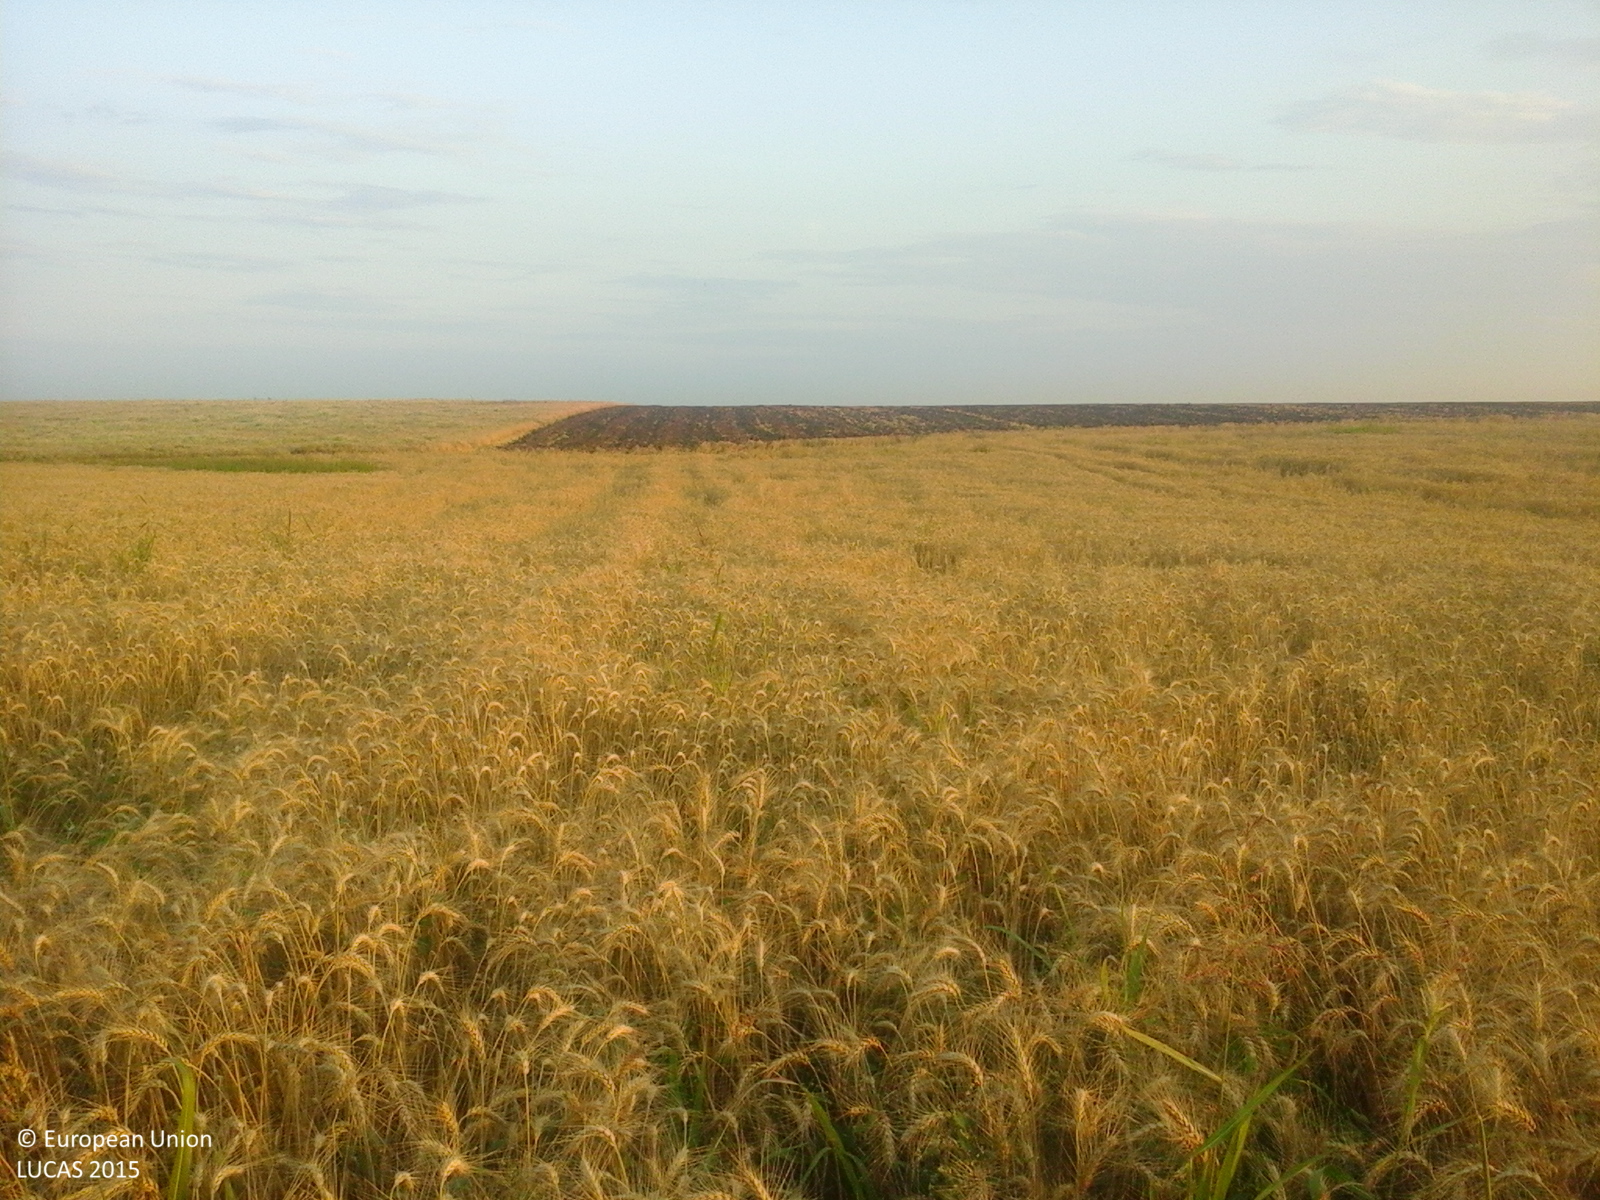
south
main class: Cropland
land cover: Common wheat
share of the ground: > 75 %
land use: Agriculture (excluding fallow land and kitchen gardens)
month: July
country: RO
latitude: 43.8838
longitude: 25.5580
